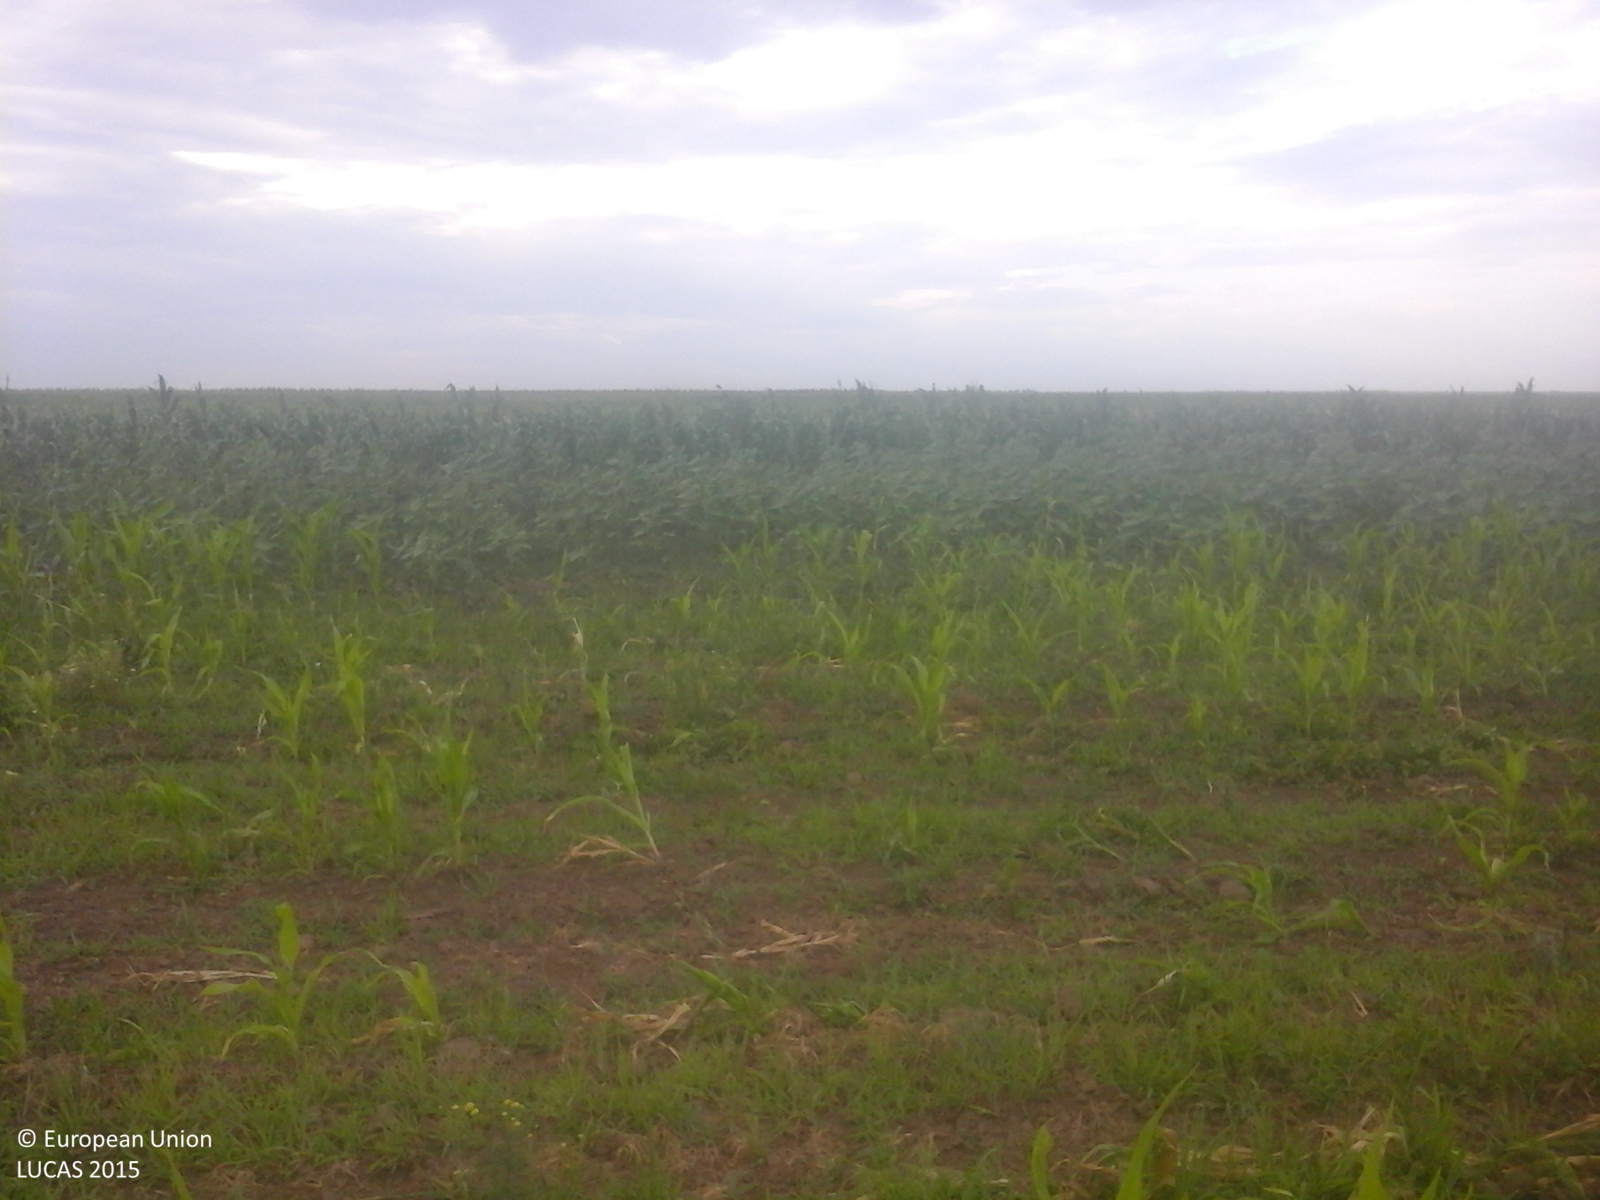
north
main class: Cropland
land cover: Maize
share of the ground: < 10 %
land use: Agriculture (excluding fallow land and kitchen gardens)
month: July
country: RO
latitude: 44.0969
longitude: 25.3616
